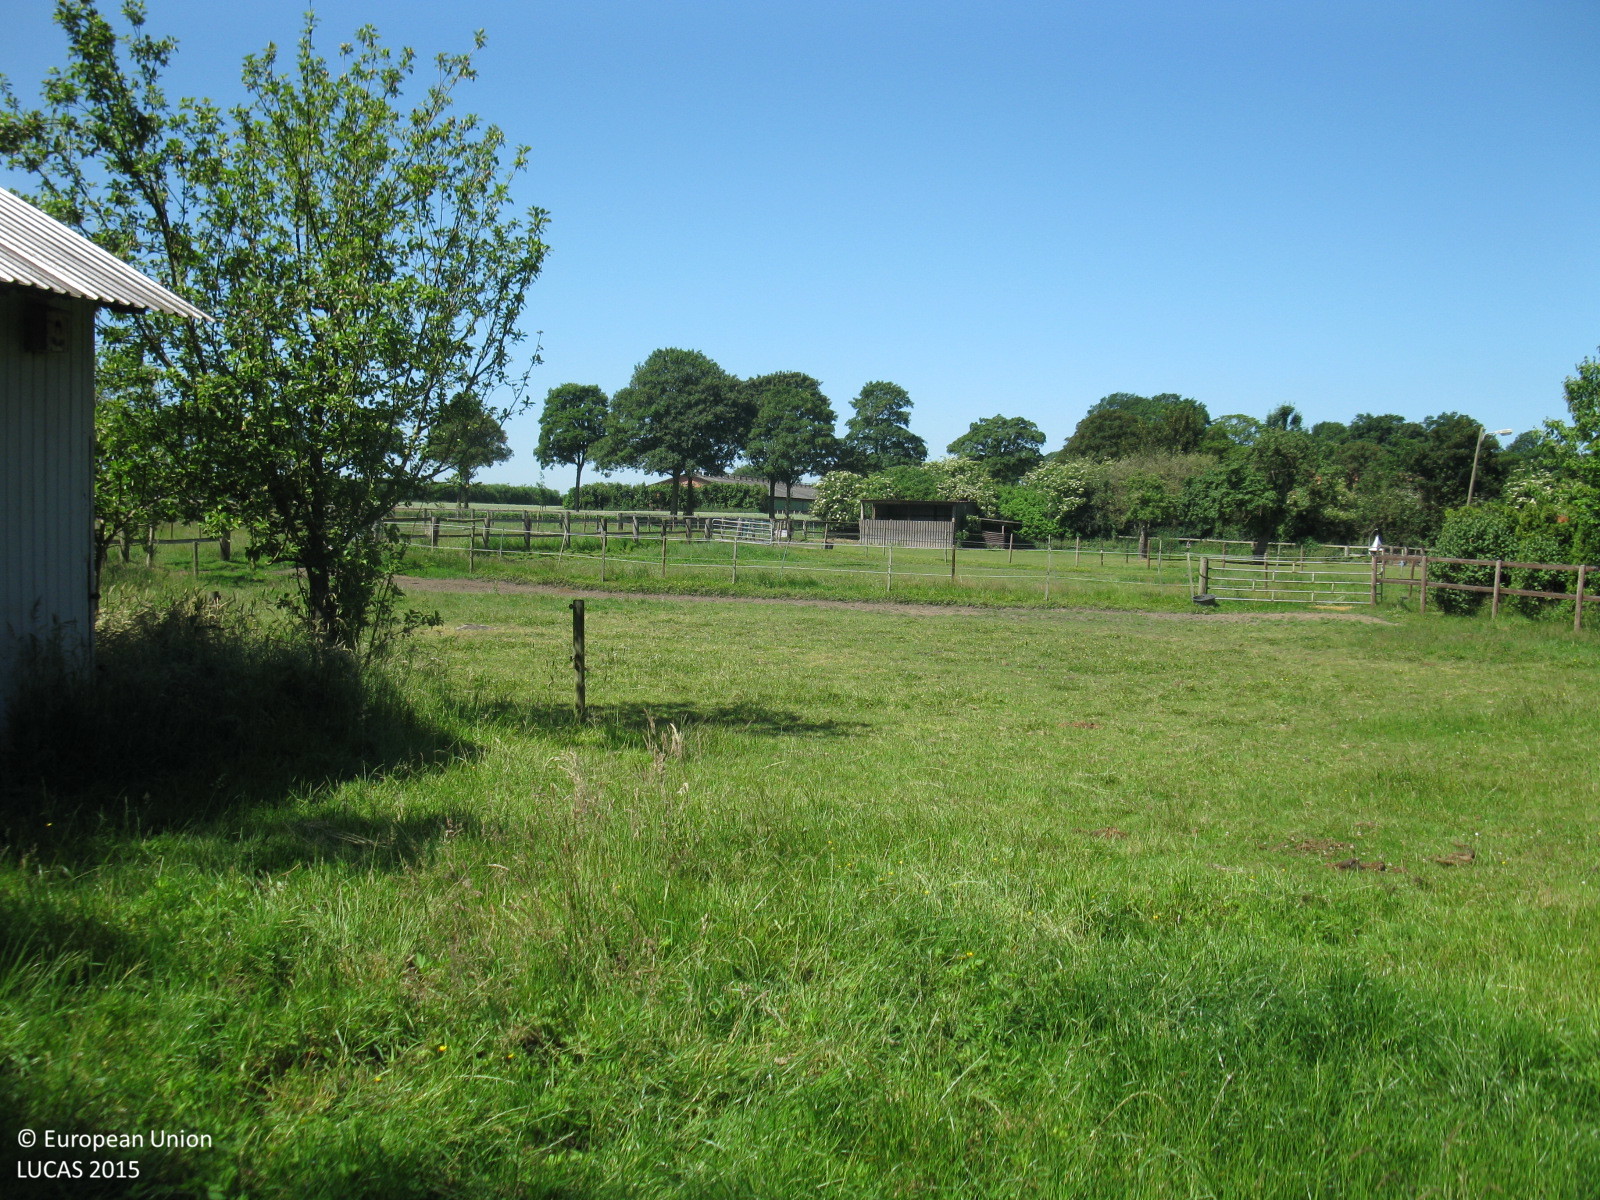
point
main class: Grassland
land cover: Grassland without tree/shrub cover
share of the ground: > 75 %
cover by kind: herbaceous plants 100 %
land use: Agriculture (excluding fallow land and kitchen gardens)
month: June
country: DE
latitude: 52.8717
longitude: 8.5297
